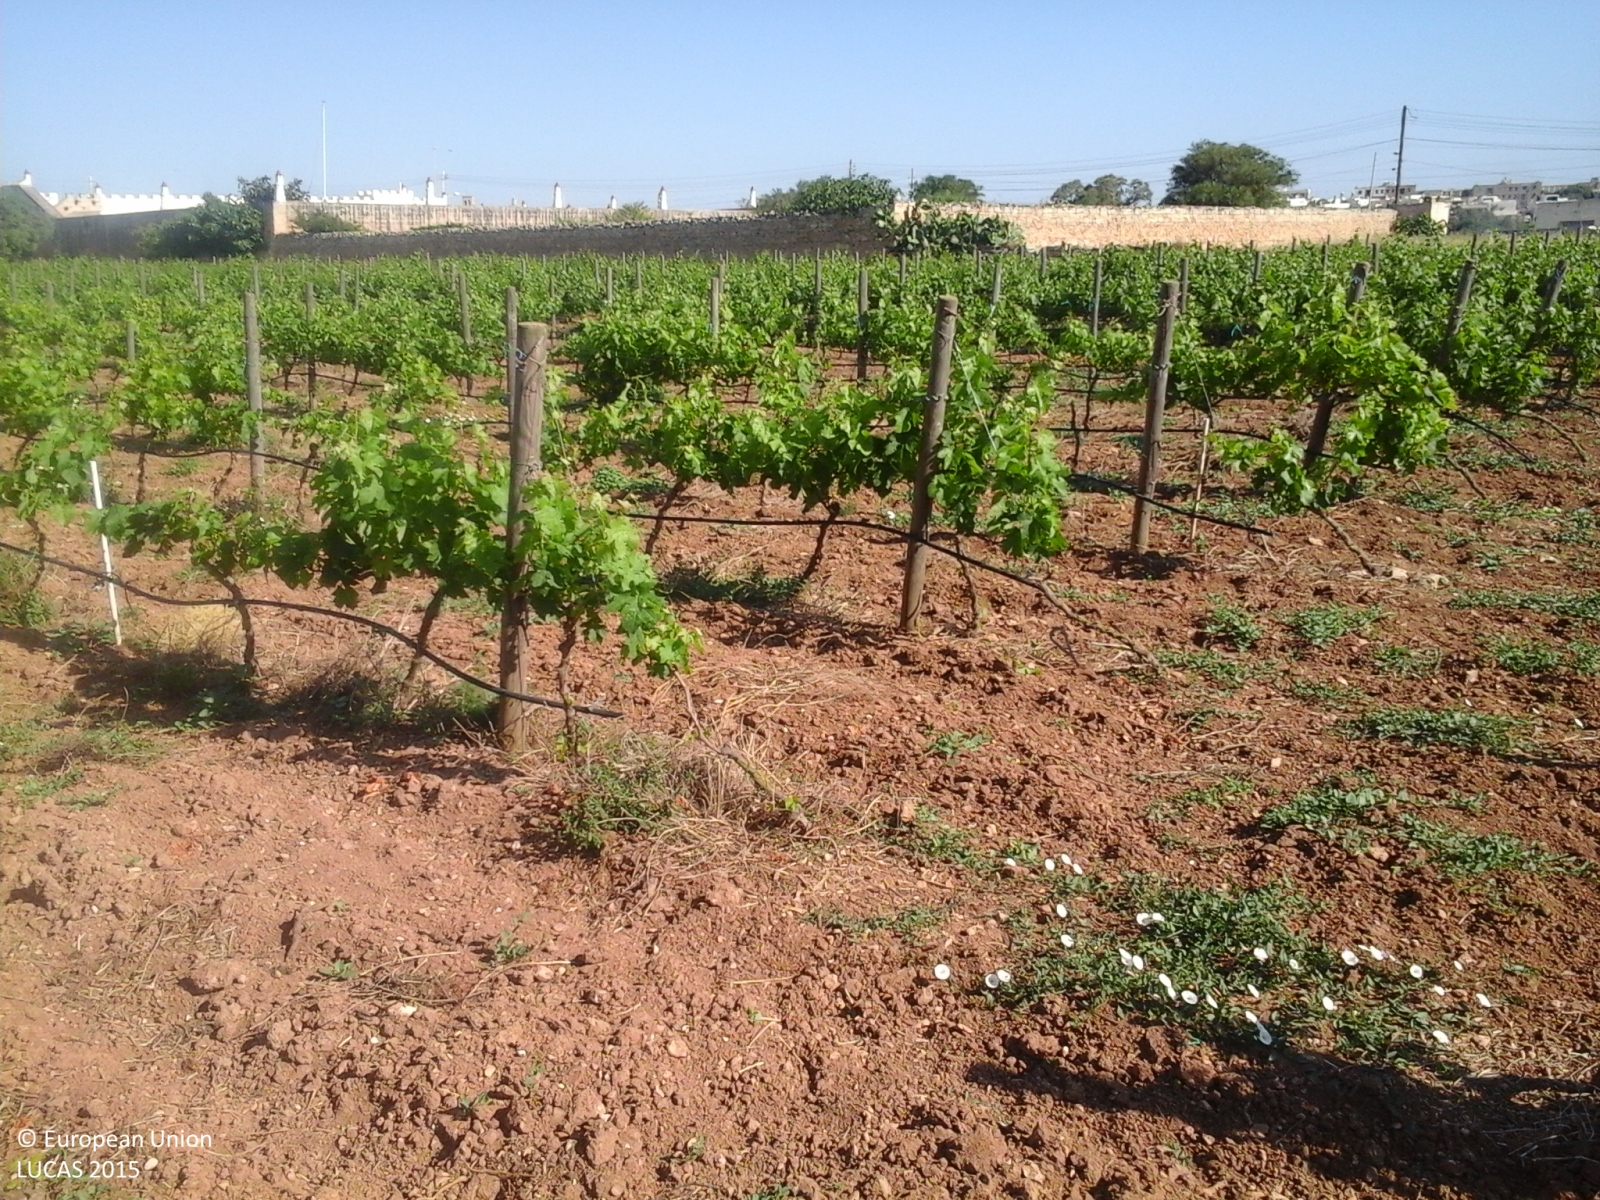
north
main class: Cropland
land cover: Vineyards
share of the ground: 25 - 50 %
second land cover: Other bare soil
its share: > 75 %
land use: Agriculture (excluding fallow land and kitchen gardens)
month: May
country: MT
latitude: 35.8571
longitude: 14.5094
